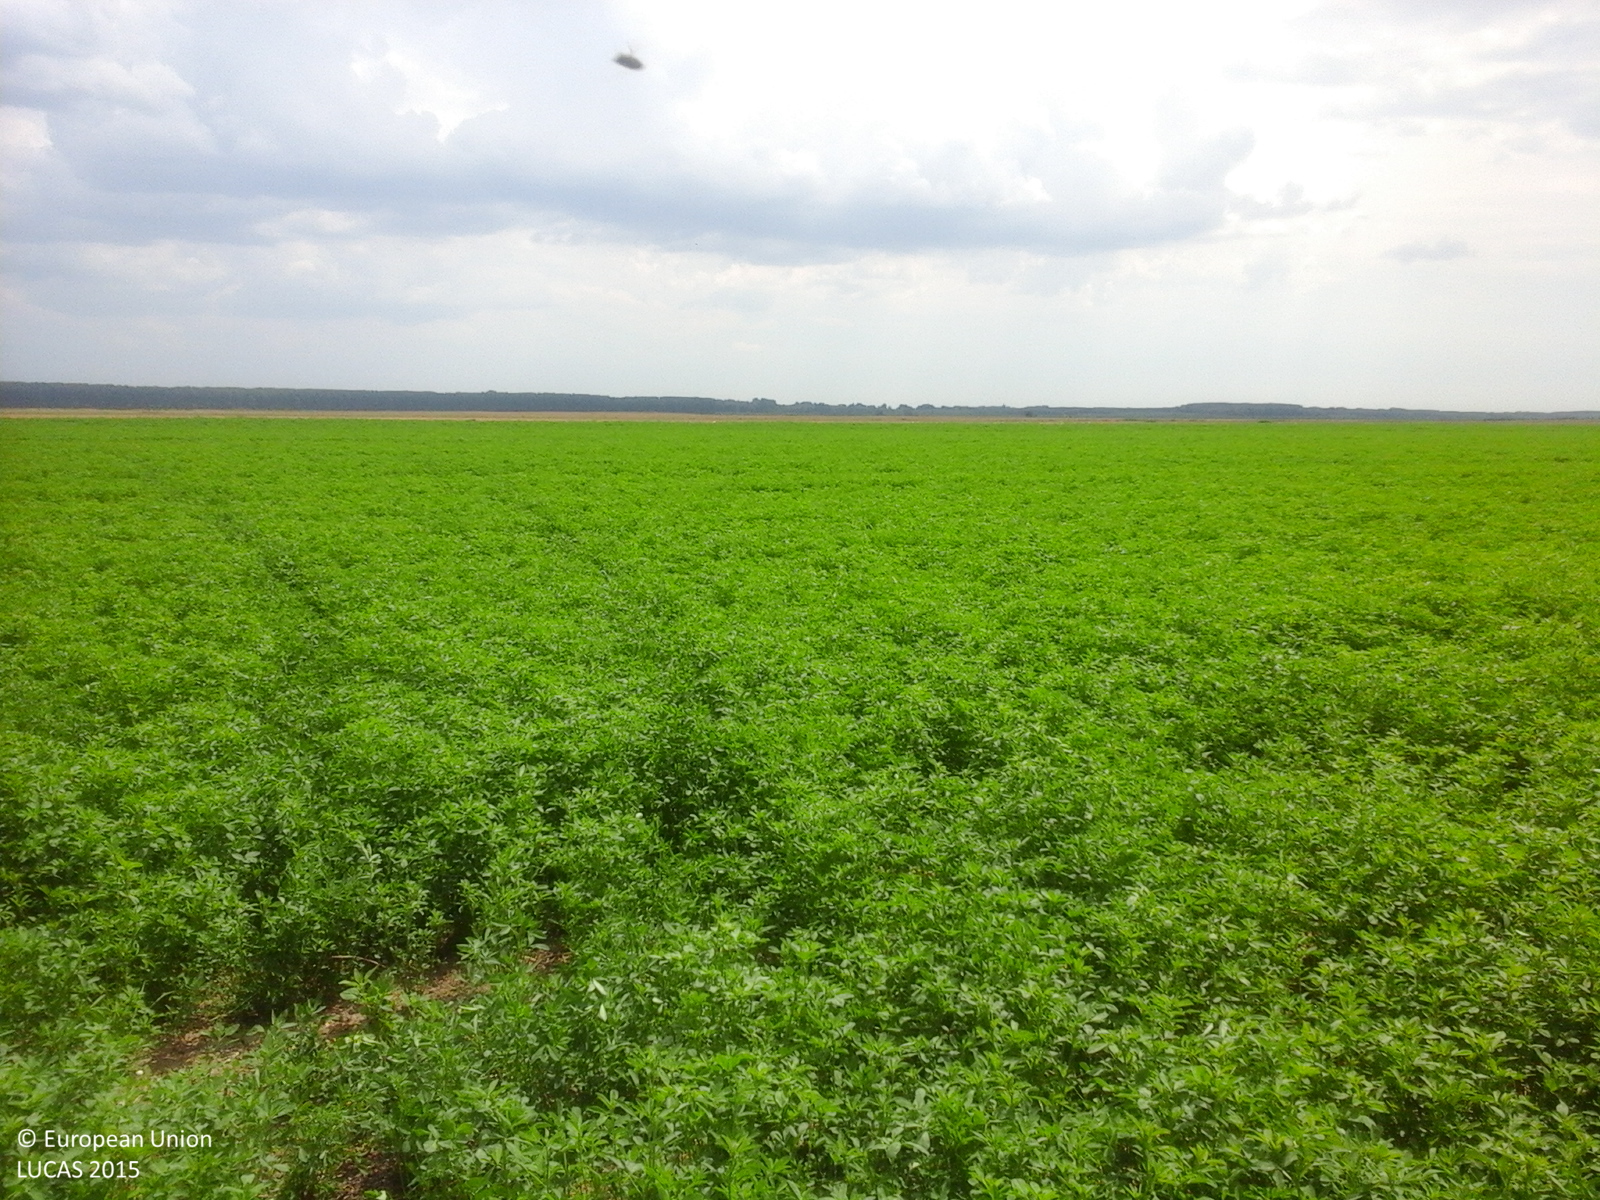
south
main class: Cropland
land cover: Lucerne
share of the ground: > 75 %
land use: Agriculture (excluding fallow land and kitchen gardens)
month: June
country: RO
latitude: 44.0581
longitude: 26.3220
